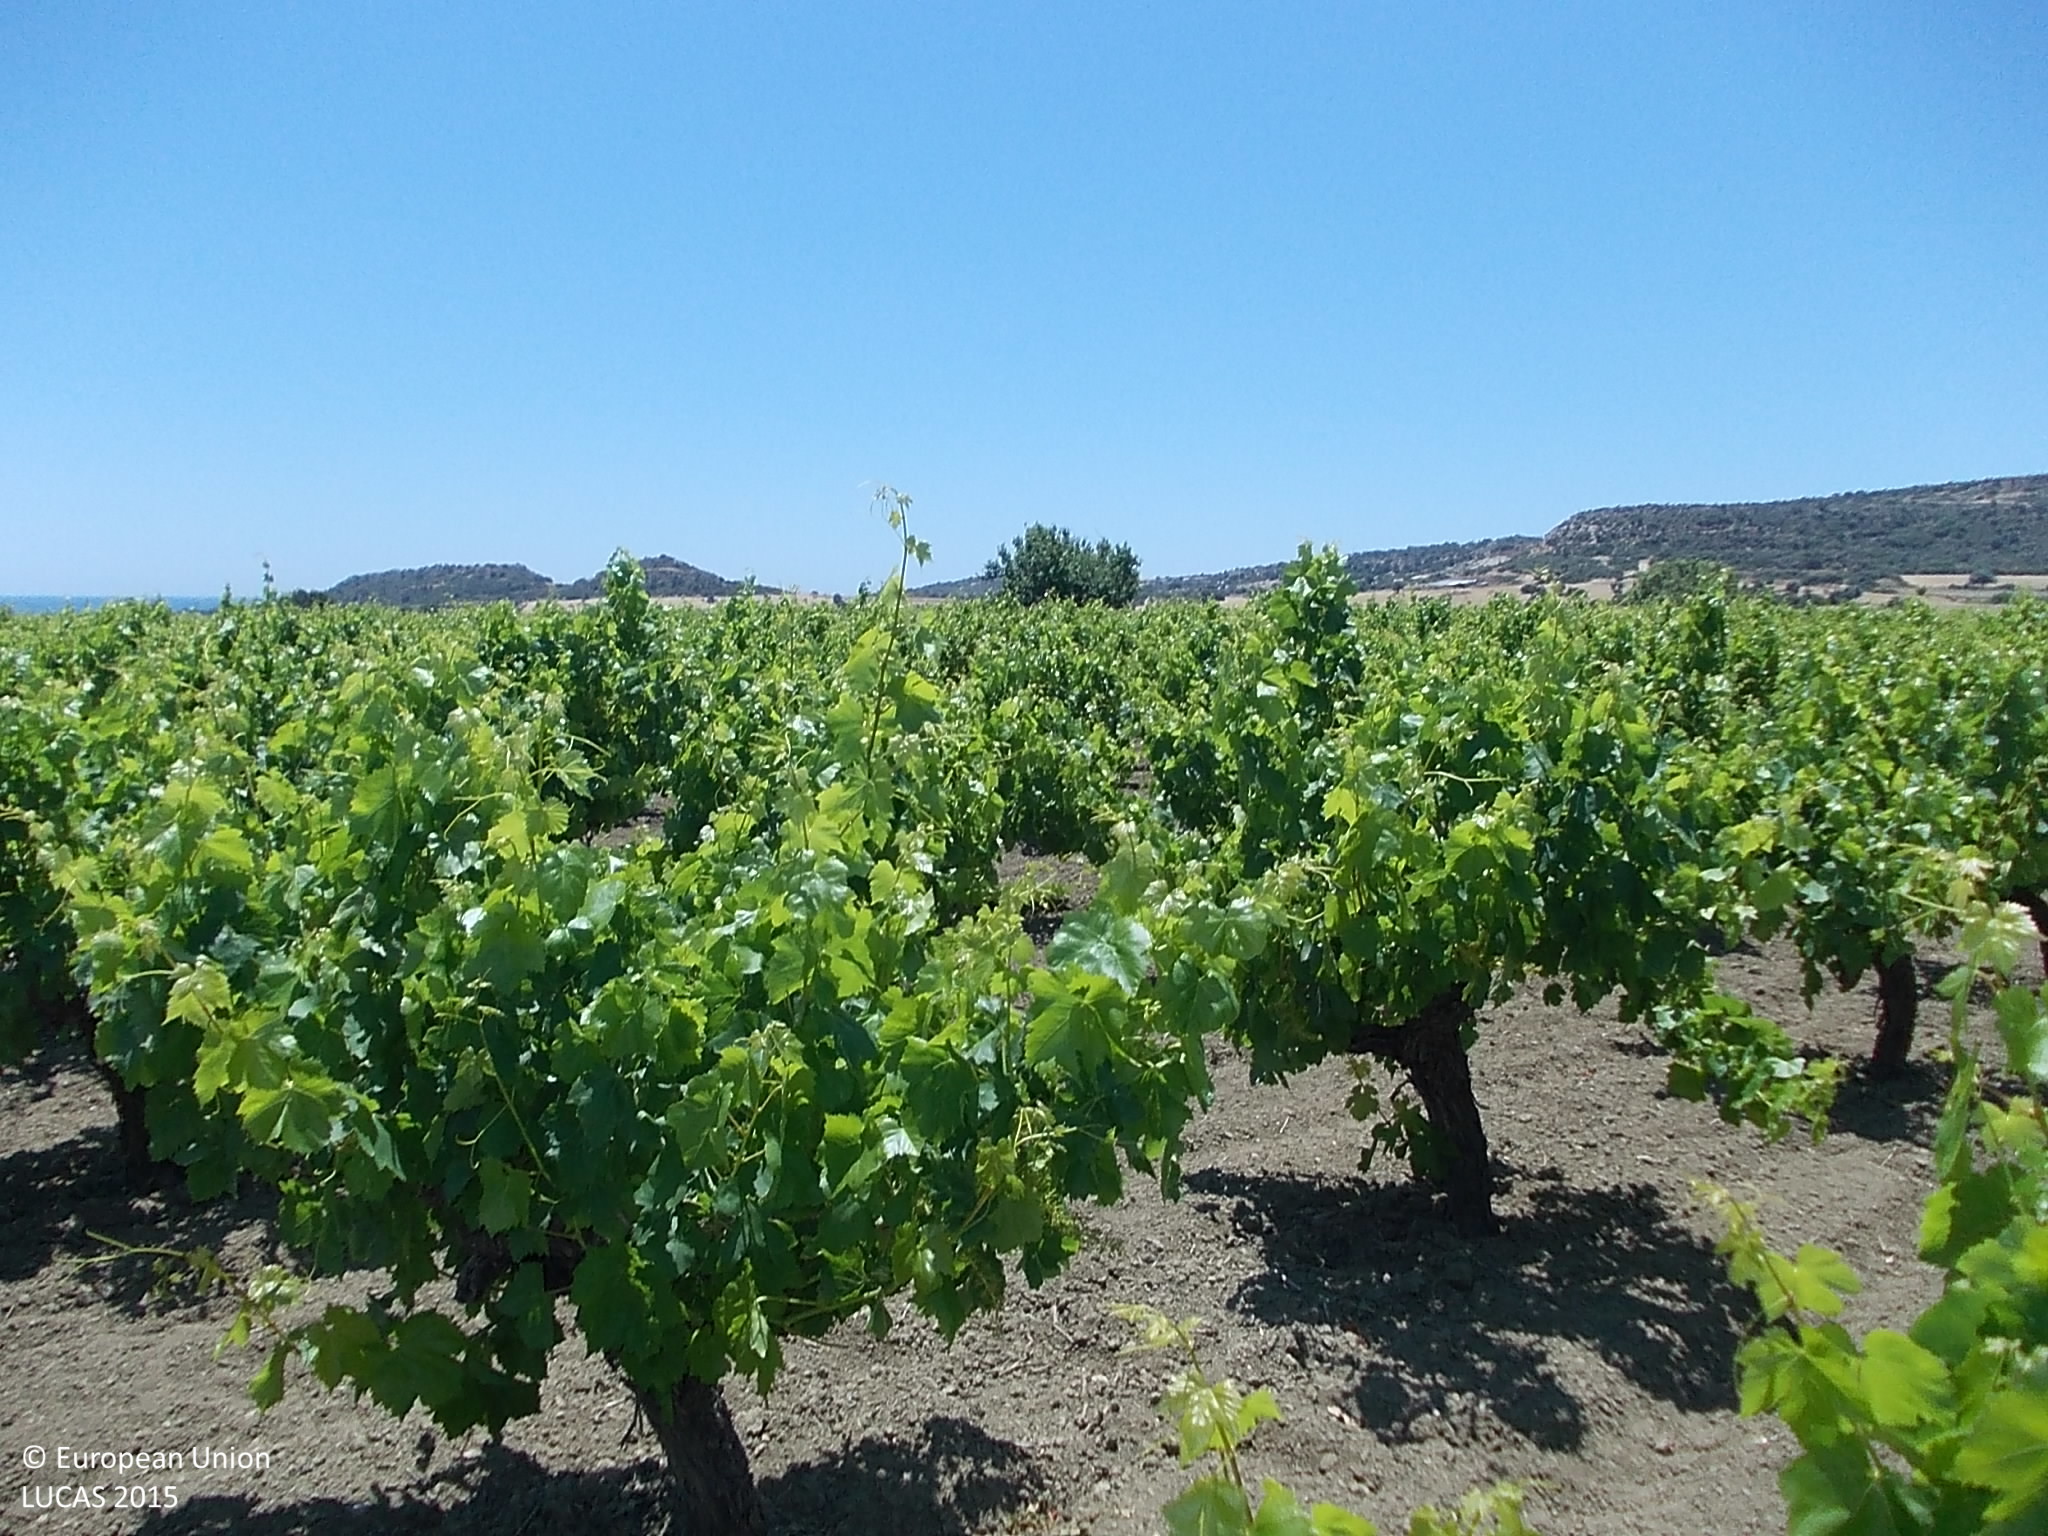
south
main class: Cropland
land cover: Vineyards
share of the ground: 50 - 75 %
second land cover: Other bare soil
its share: > 75 %
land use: Agriculture (excluding fallow land and kitchen gardens)
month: May
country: CY
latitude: 34.6690
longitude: 32.7542
